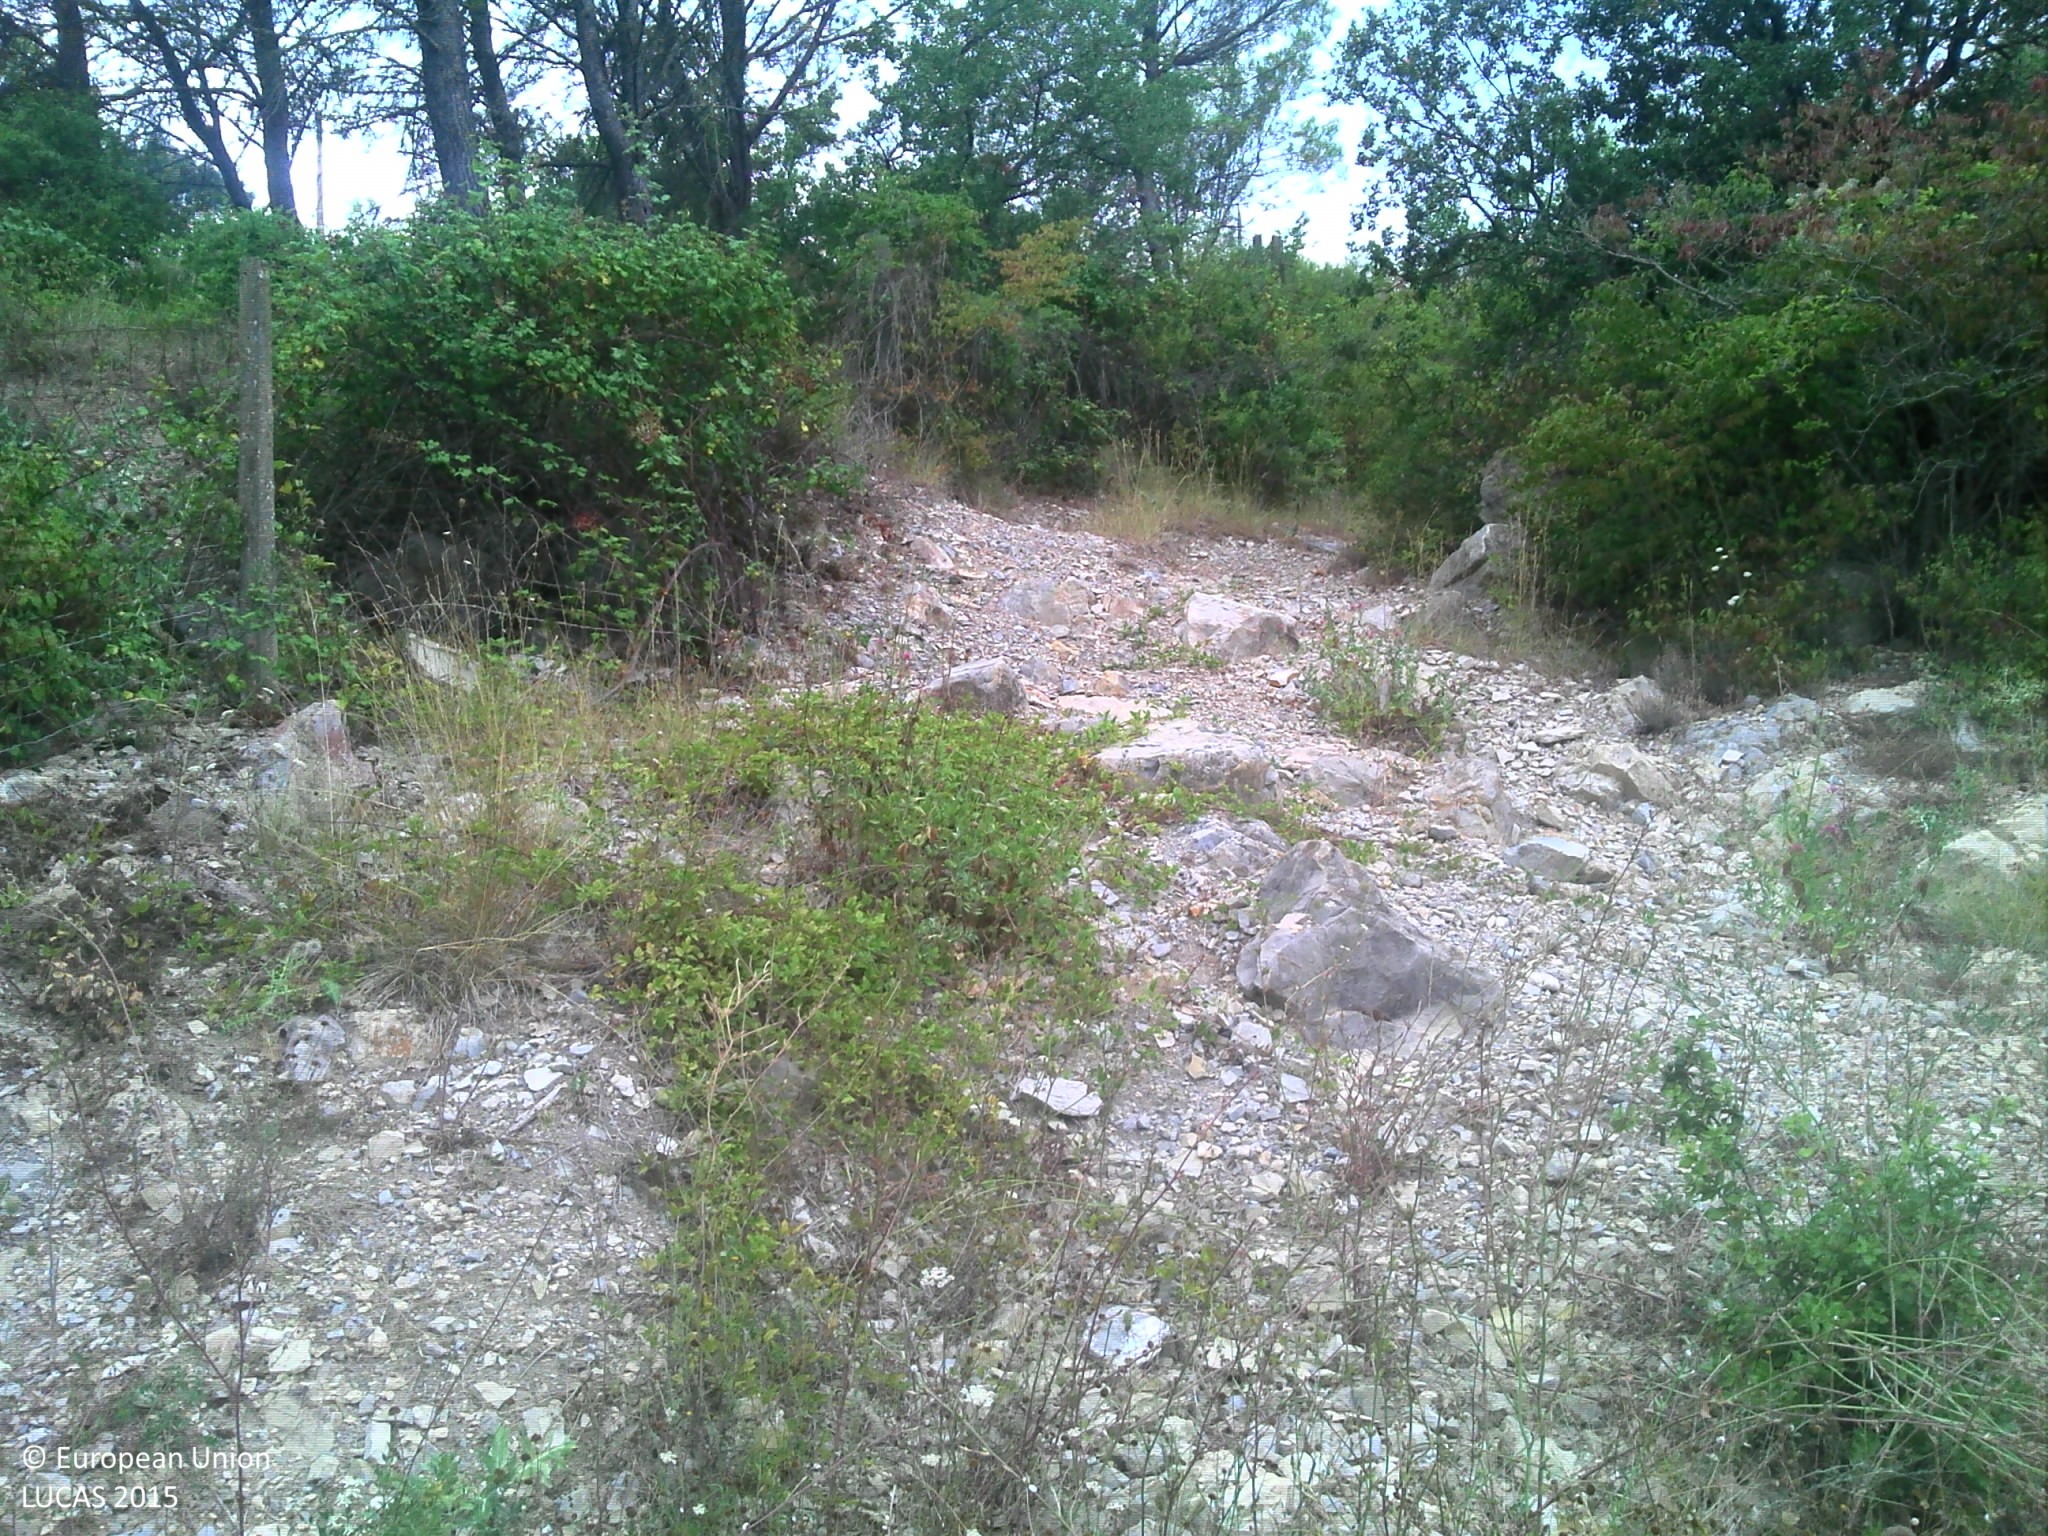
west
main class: Woodland
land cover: Pine dominated mixed woodland
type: coniferous forest of the mediterranean region
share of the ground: > 75 %
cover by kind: coniferous forest trees 45 %, broadleaved forest trees 30 %, shrubs 25 %
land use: Sport
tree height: < 5 m
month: August
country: FR
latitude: 43.4251
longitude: 5.5754
